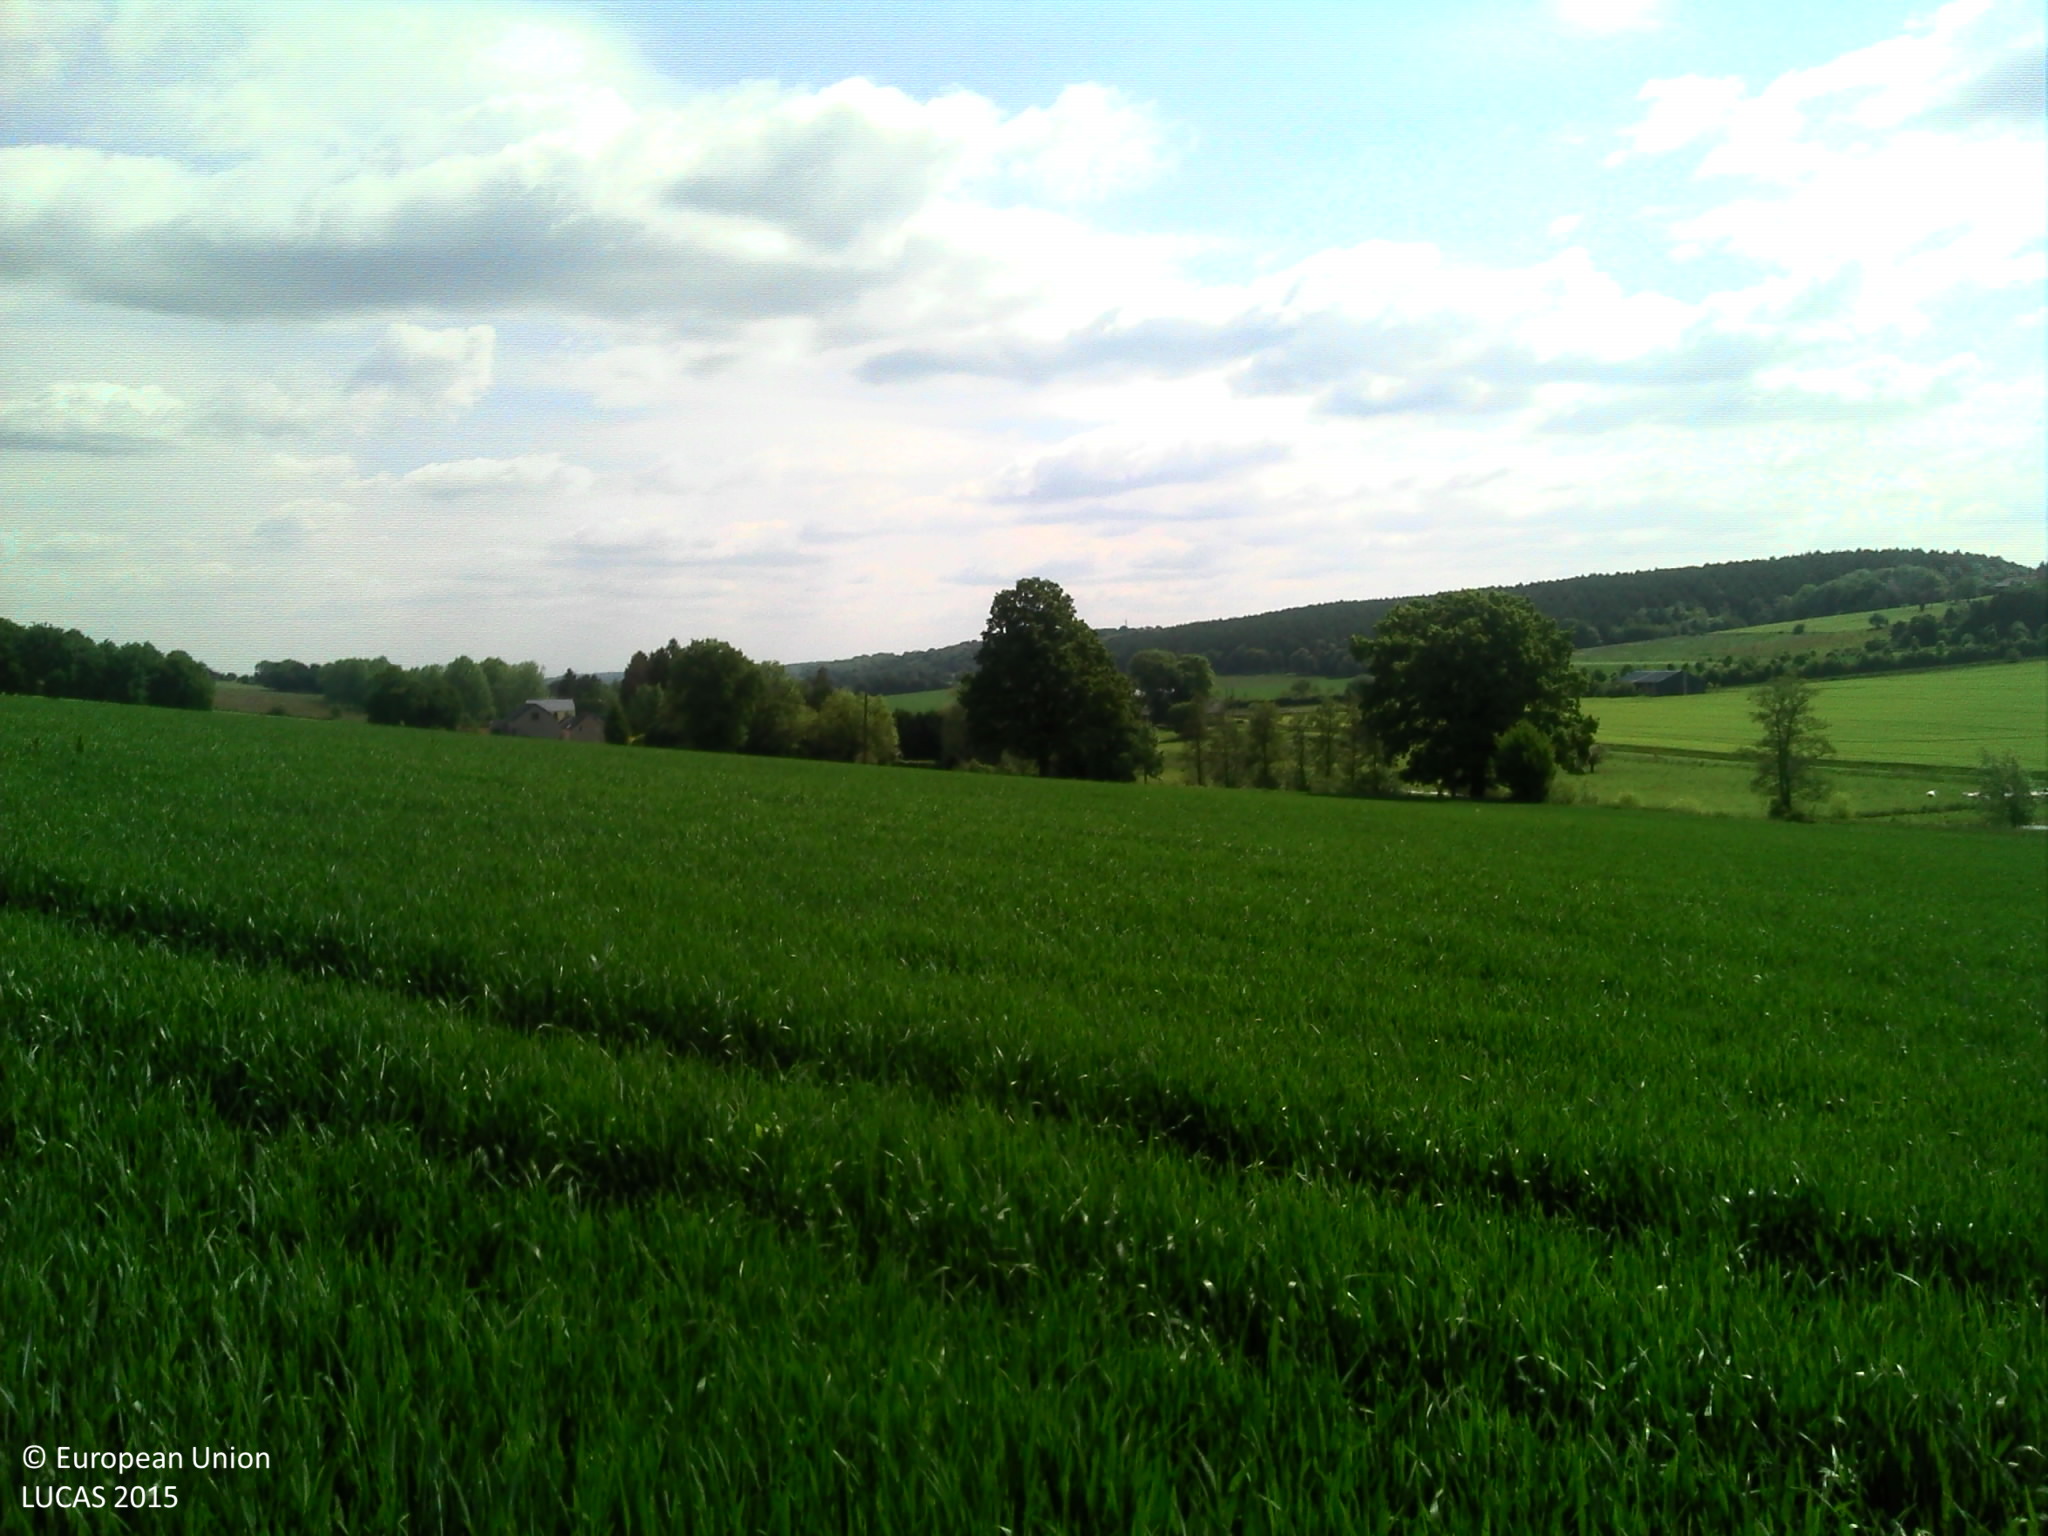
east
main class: Cropland
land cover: Common wheat
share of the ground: > 75 %
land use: Agriculture (excluding fallow land and kitchen gardens)
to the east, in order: Common wheat; Grassland without tree/shrub cover; Electric lines; Fences; Single bushes/trees; Grassland without tree/shrub cover; Electric lines; Grassland without tree/shrub cover; Fences; Lines of trees
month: May
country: BE
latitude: 50.4612
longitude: 5.1940
